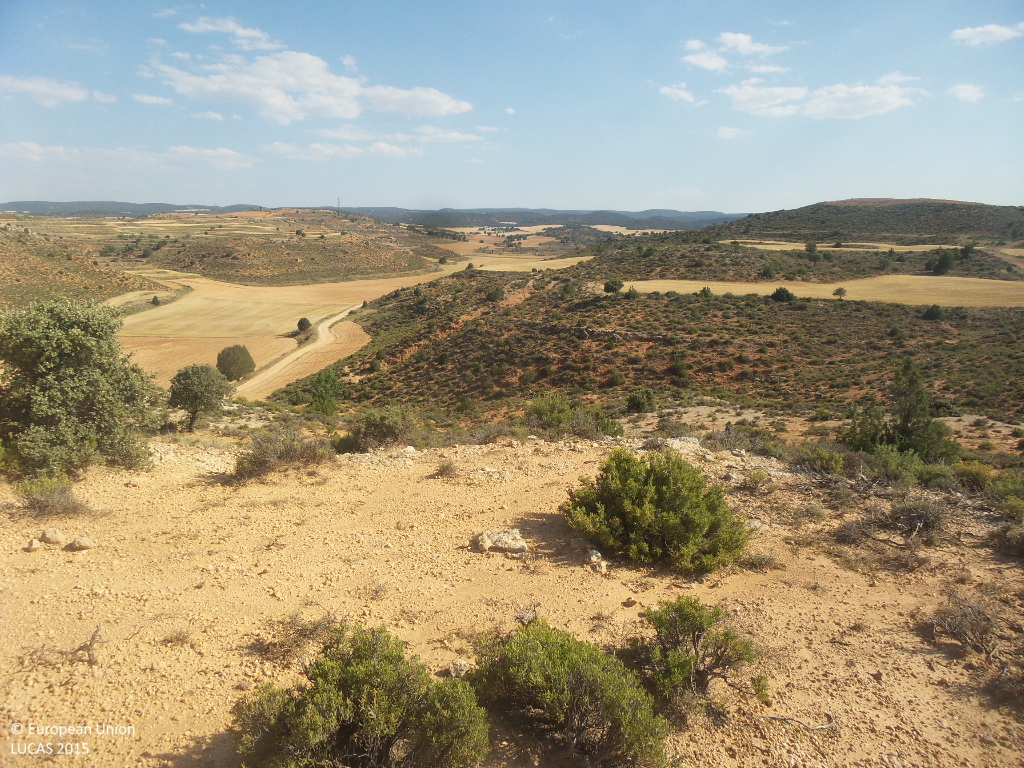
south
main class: Shrubland
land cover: Shrubland without tree cover
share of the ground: 25 - 50 %
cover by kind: unconsolidated bare surface 70 %, shrubs 30 %
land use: Semi-natural and natural areas not in use
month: July
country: ES
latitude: 41.2099
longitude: -2.1338
